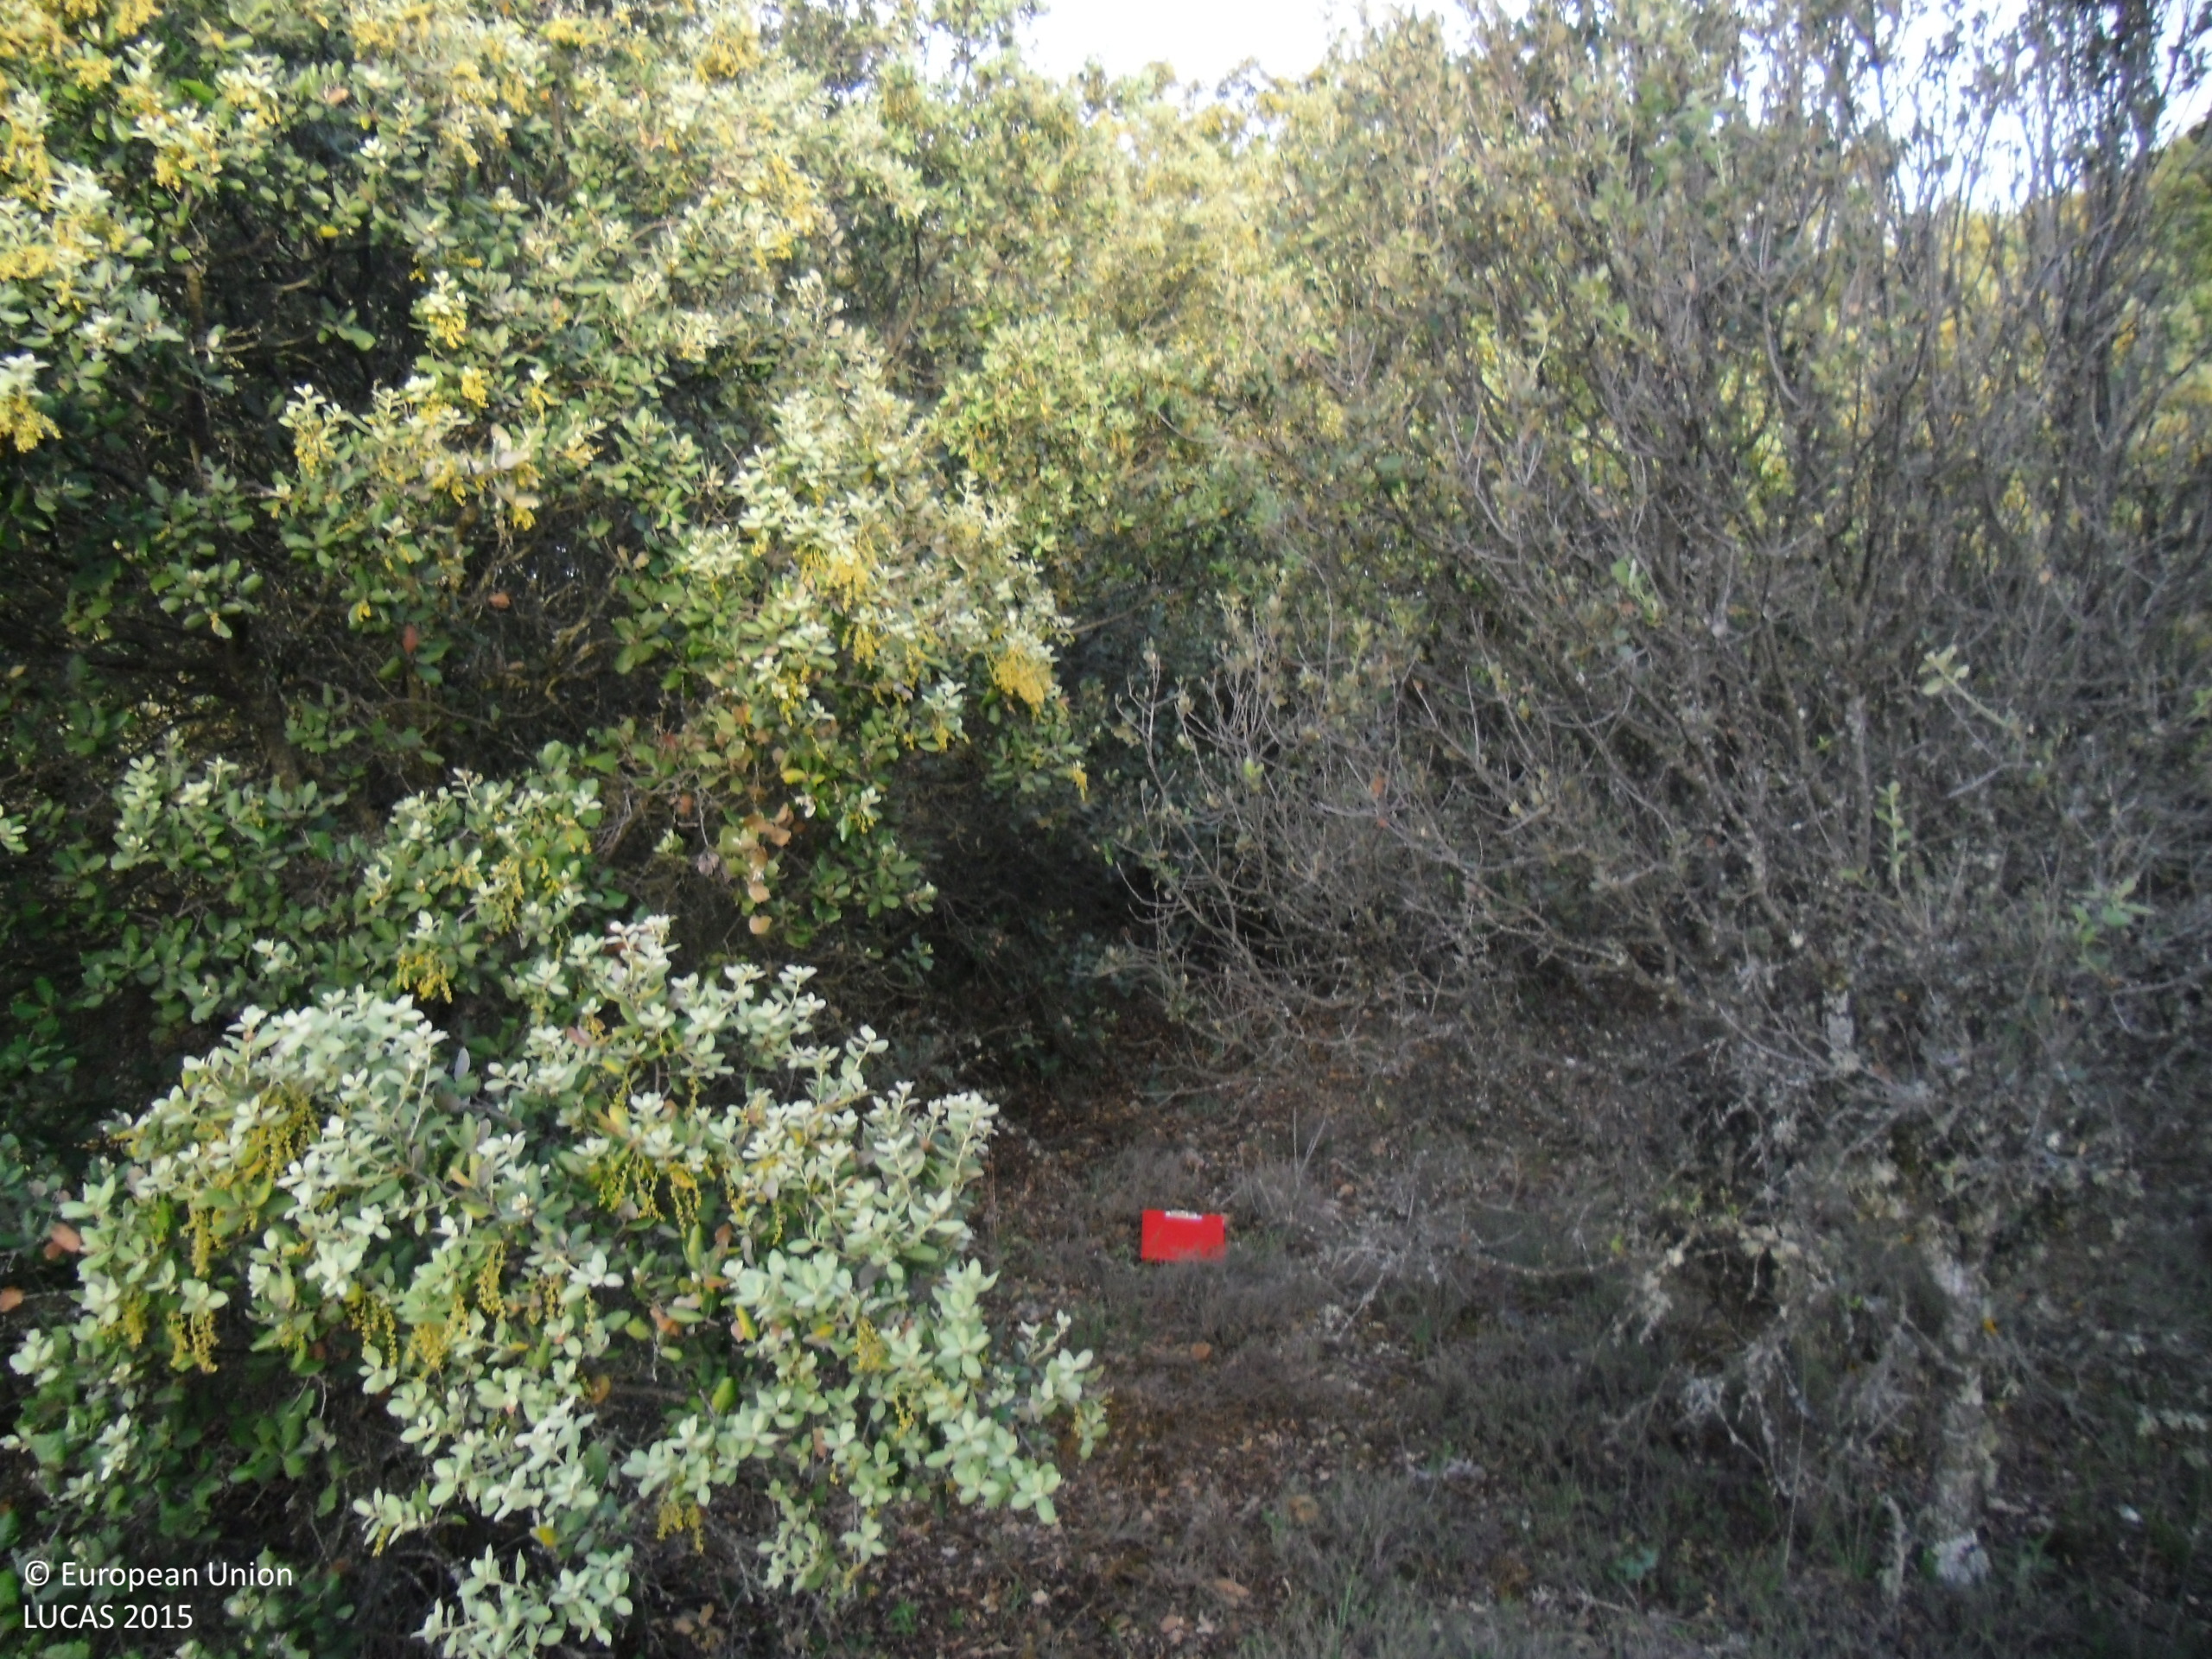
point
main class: Woodland
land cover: Broadleaved woodland
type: broadleaved evergreen forest
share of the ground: 50 - 75 %
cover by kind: broadleaved forest trees 60 %, herbaceous plants 25 %, shrubs 15 %
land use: Semi-natural and natural areas not in use
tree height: > 5 m
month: May
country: ES
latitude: 40.6211
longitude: -3.0229
